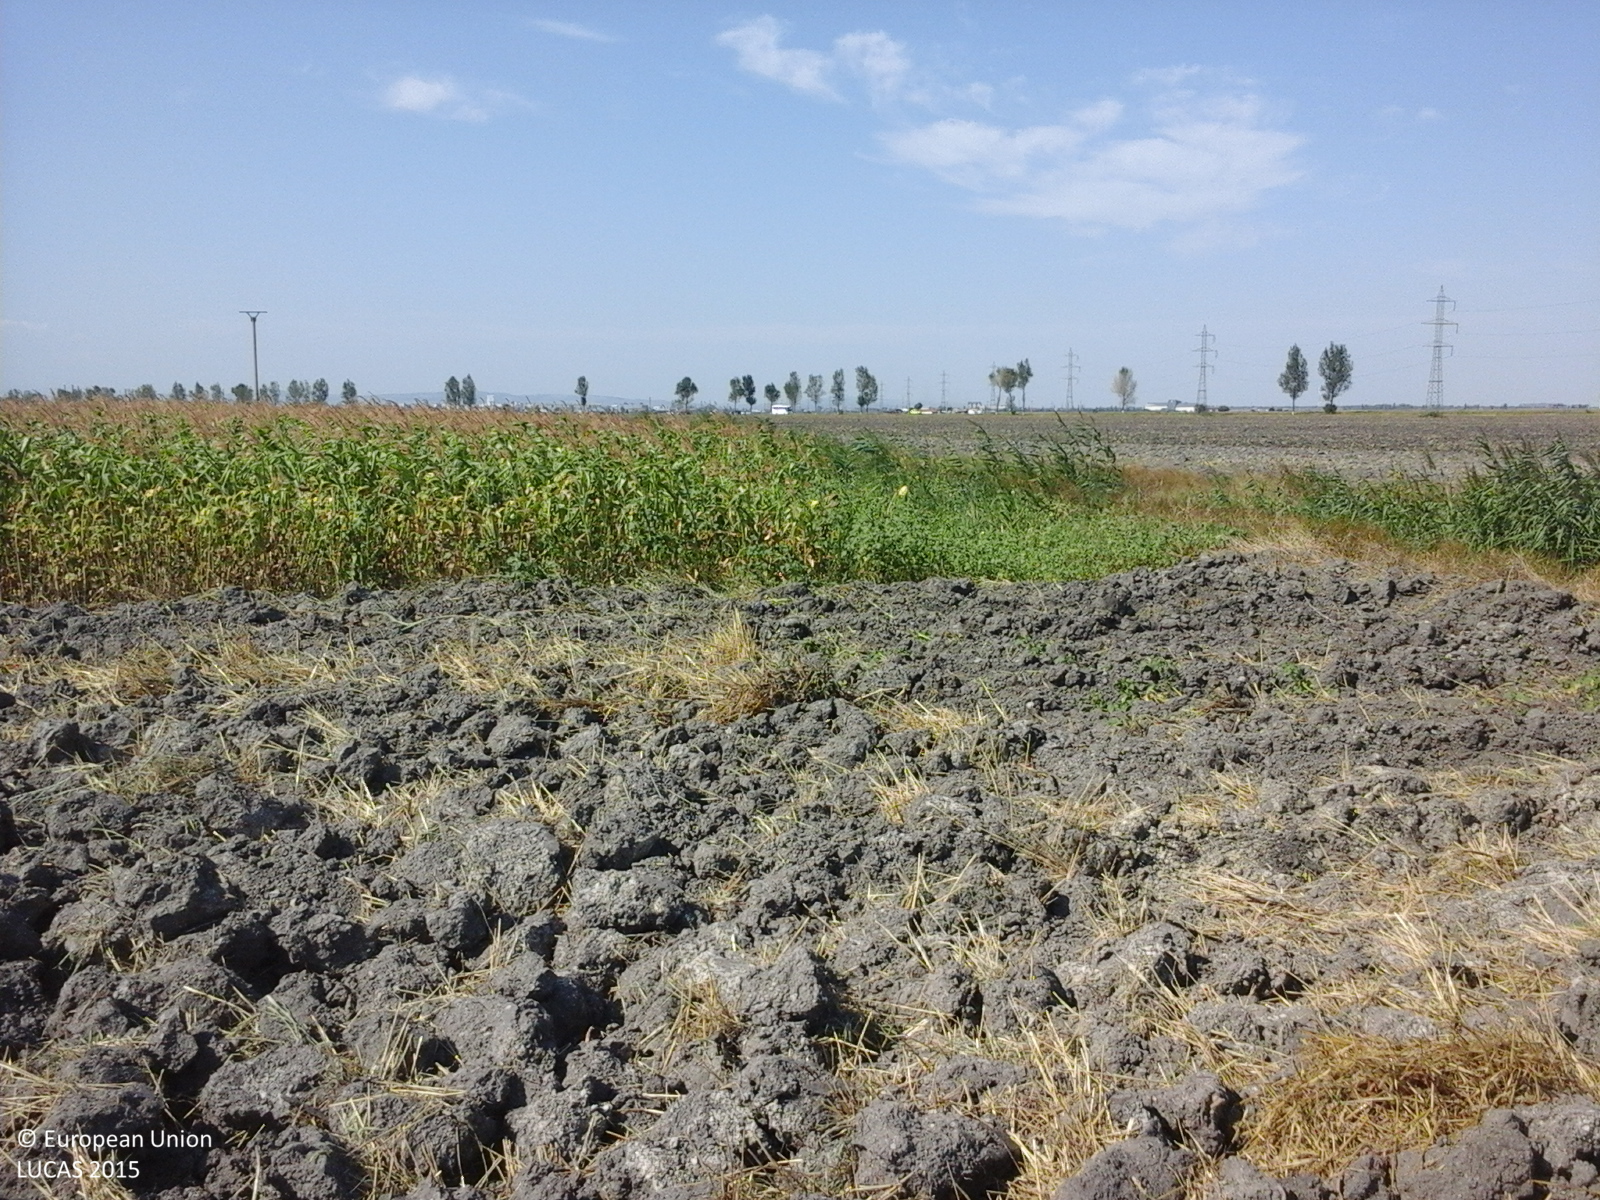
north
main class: Cropland
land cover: Common wheat
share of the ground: < 10 %
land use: Agriculture (excluding fallow land and kitchen gardens)
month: August
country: RO
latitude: 45.0955
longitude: 26.8404
